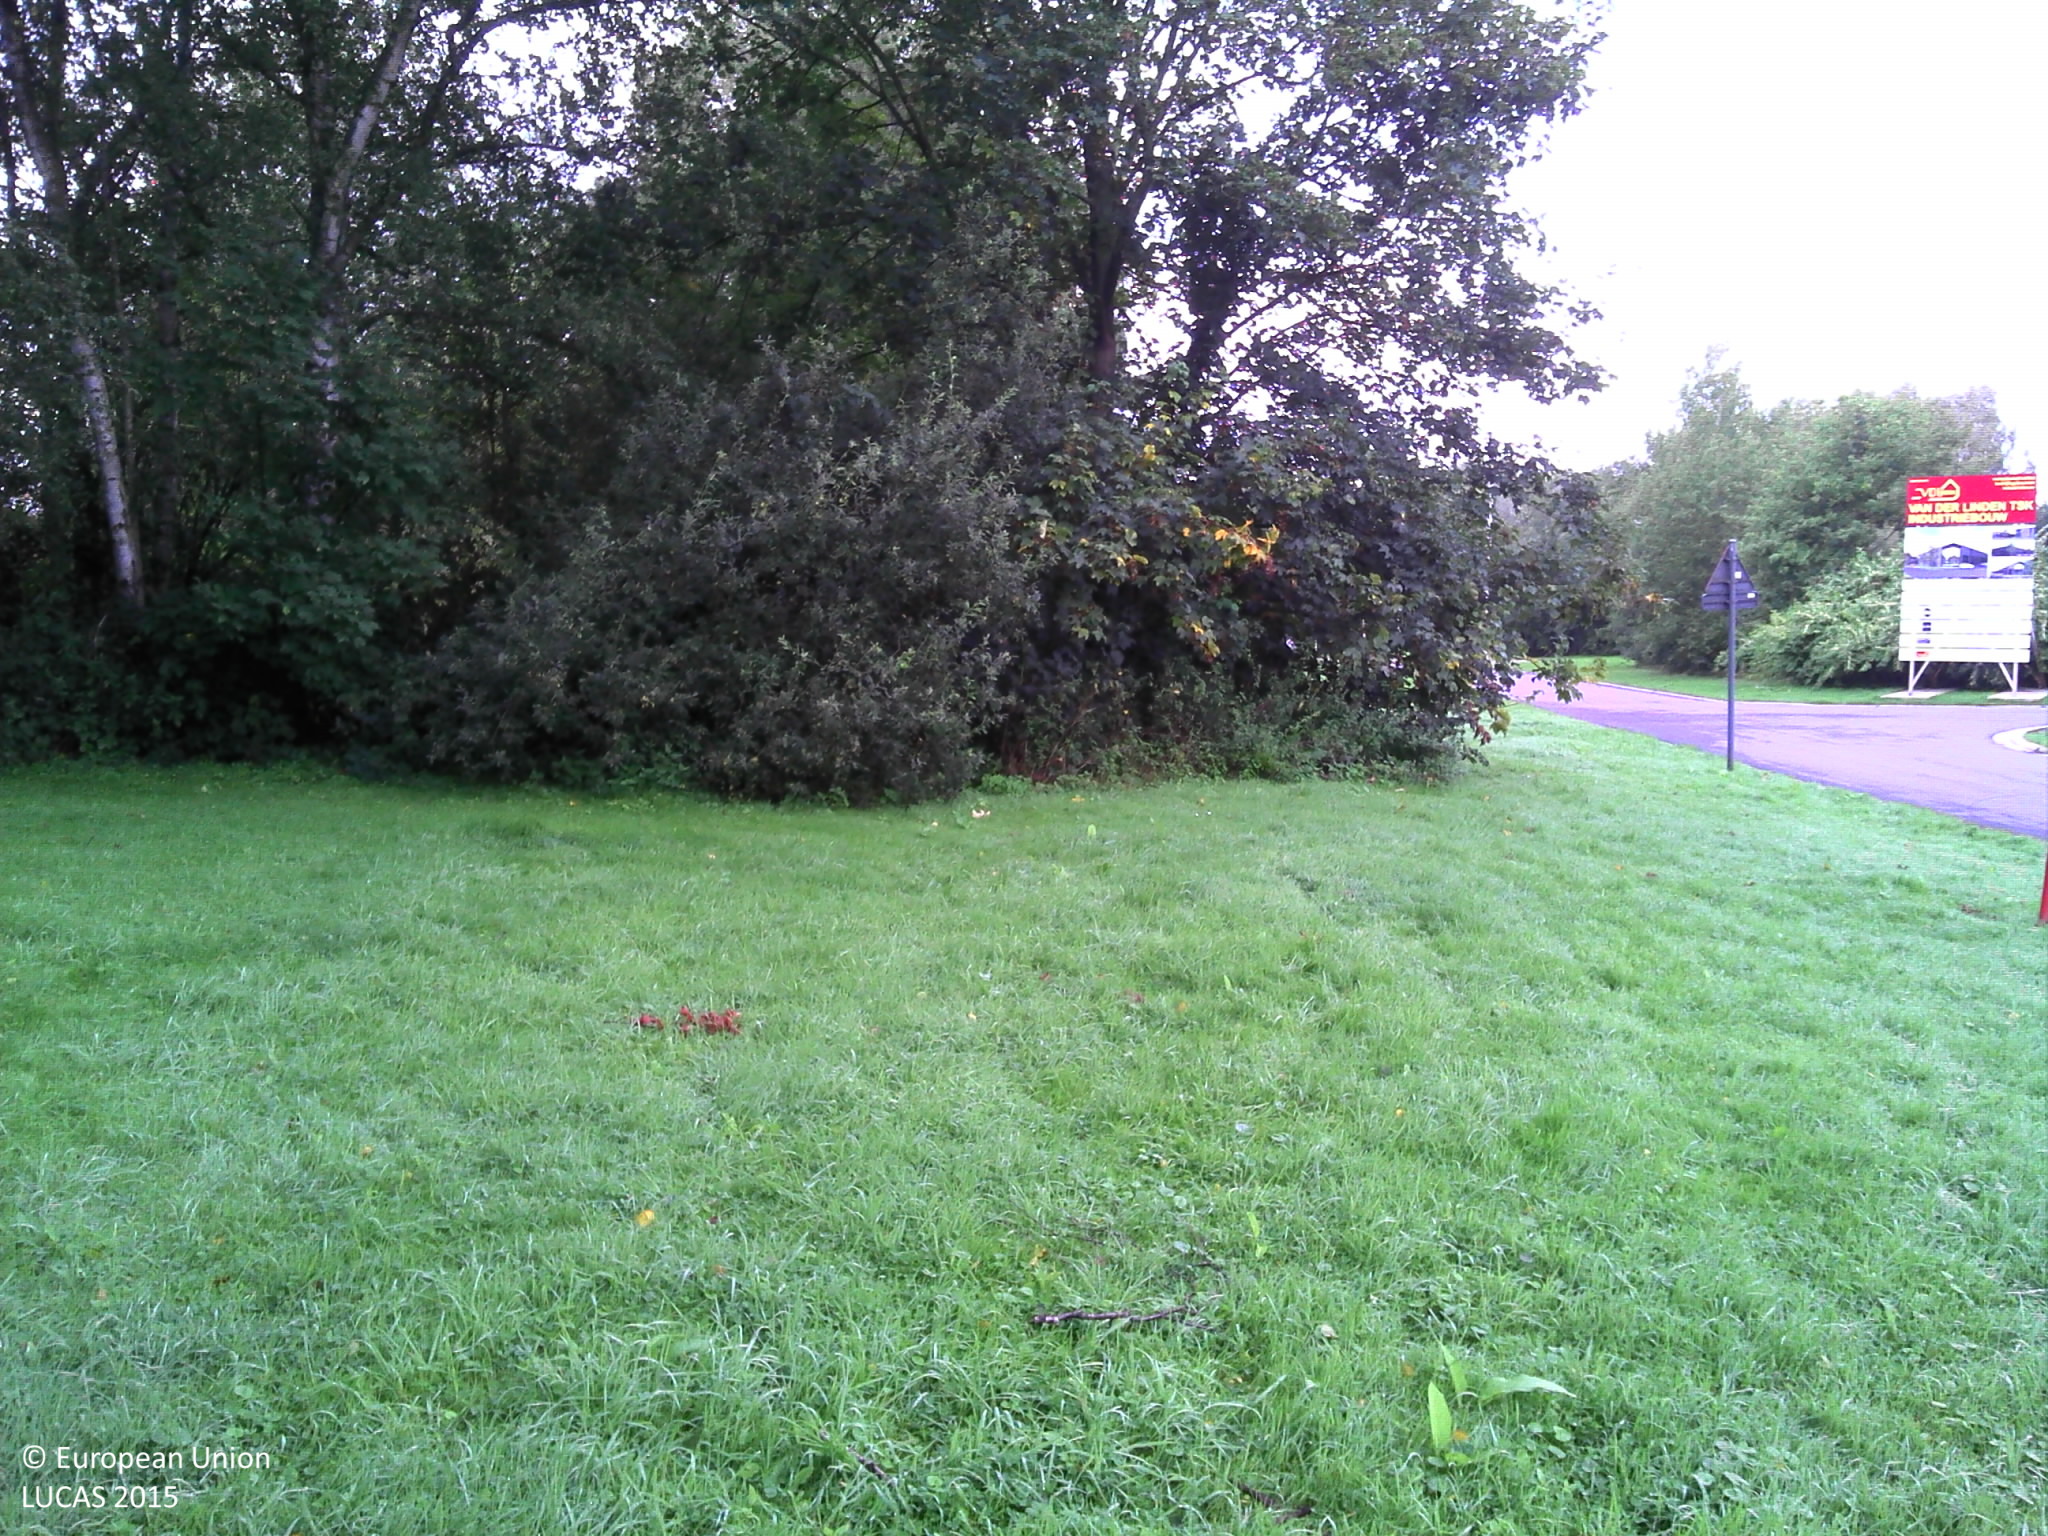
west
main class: Grassland
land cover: Grassland without tree/shrub cover
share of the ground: > 75 %
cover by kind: herbaceous plants 100 %
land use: Road transport
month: September
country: BE
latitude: 51.1078
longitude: 4.3536
